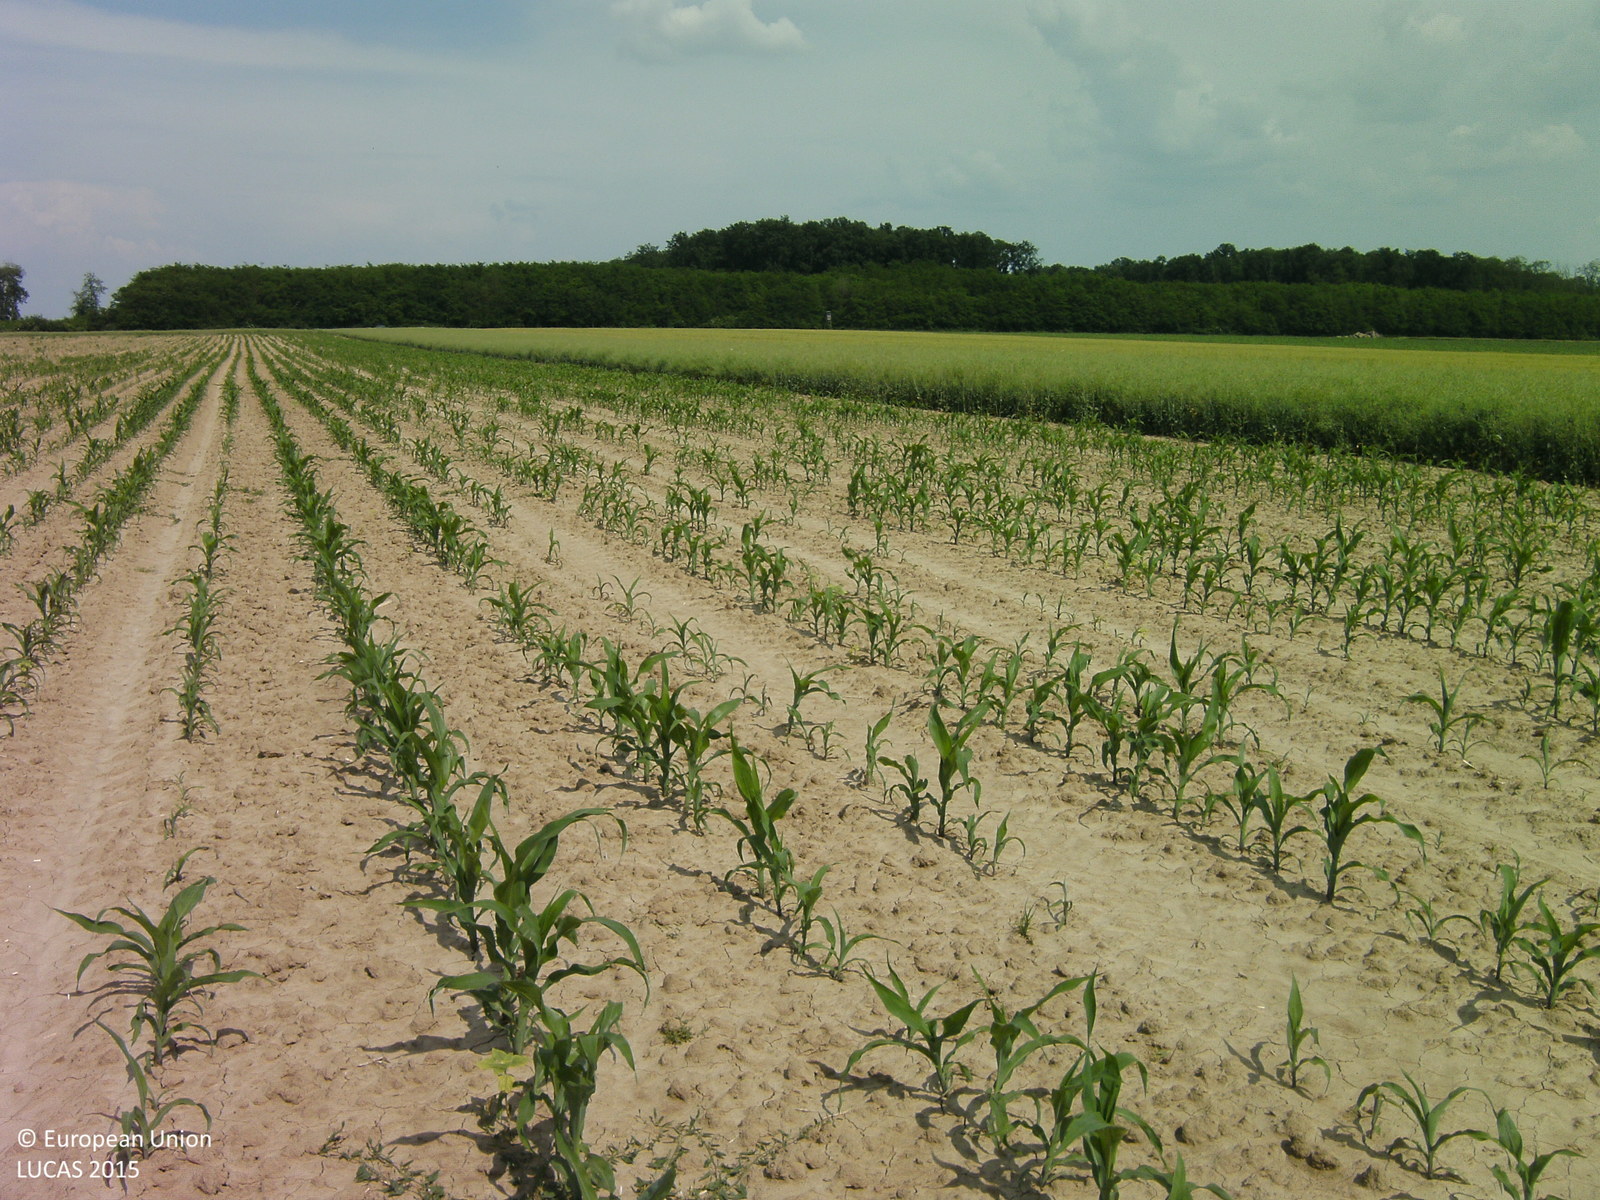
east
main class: Cropland
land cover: Maize
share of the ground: 10 - 25 %
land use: Agriculture (excluding fallow land and kitchen gardens)
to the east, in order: Maize; Rape and turnip rape; Barley
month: June
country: HU
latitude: 46.4316
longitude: 17.7492
